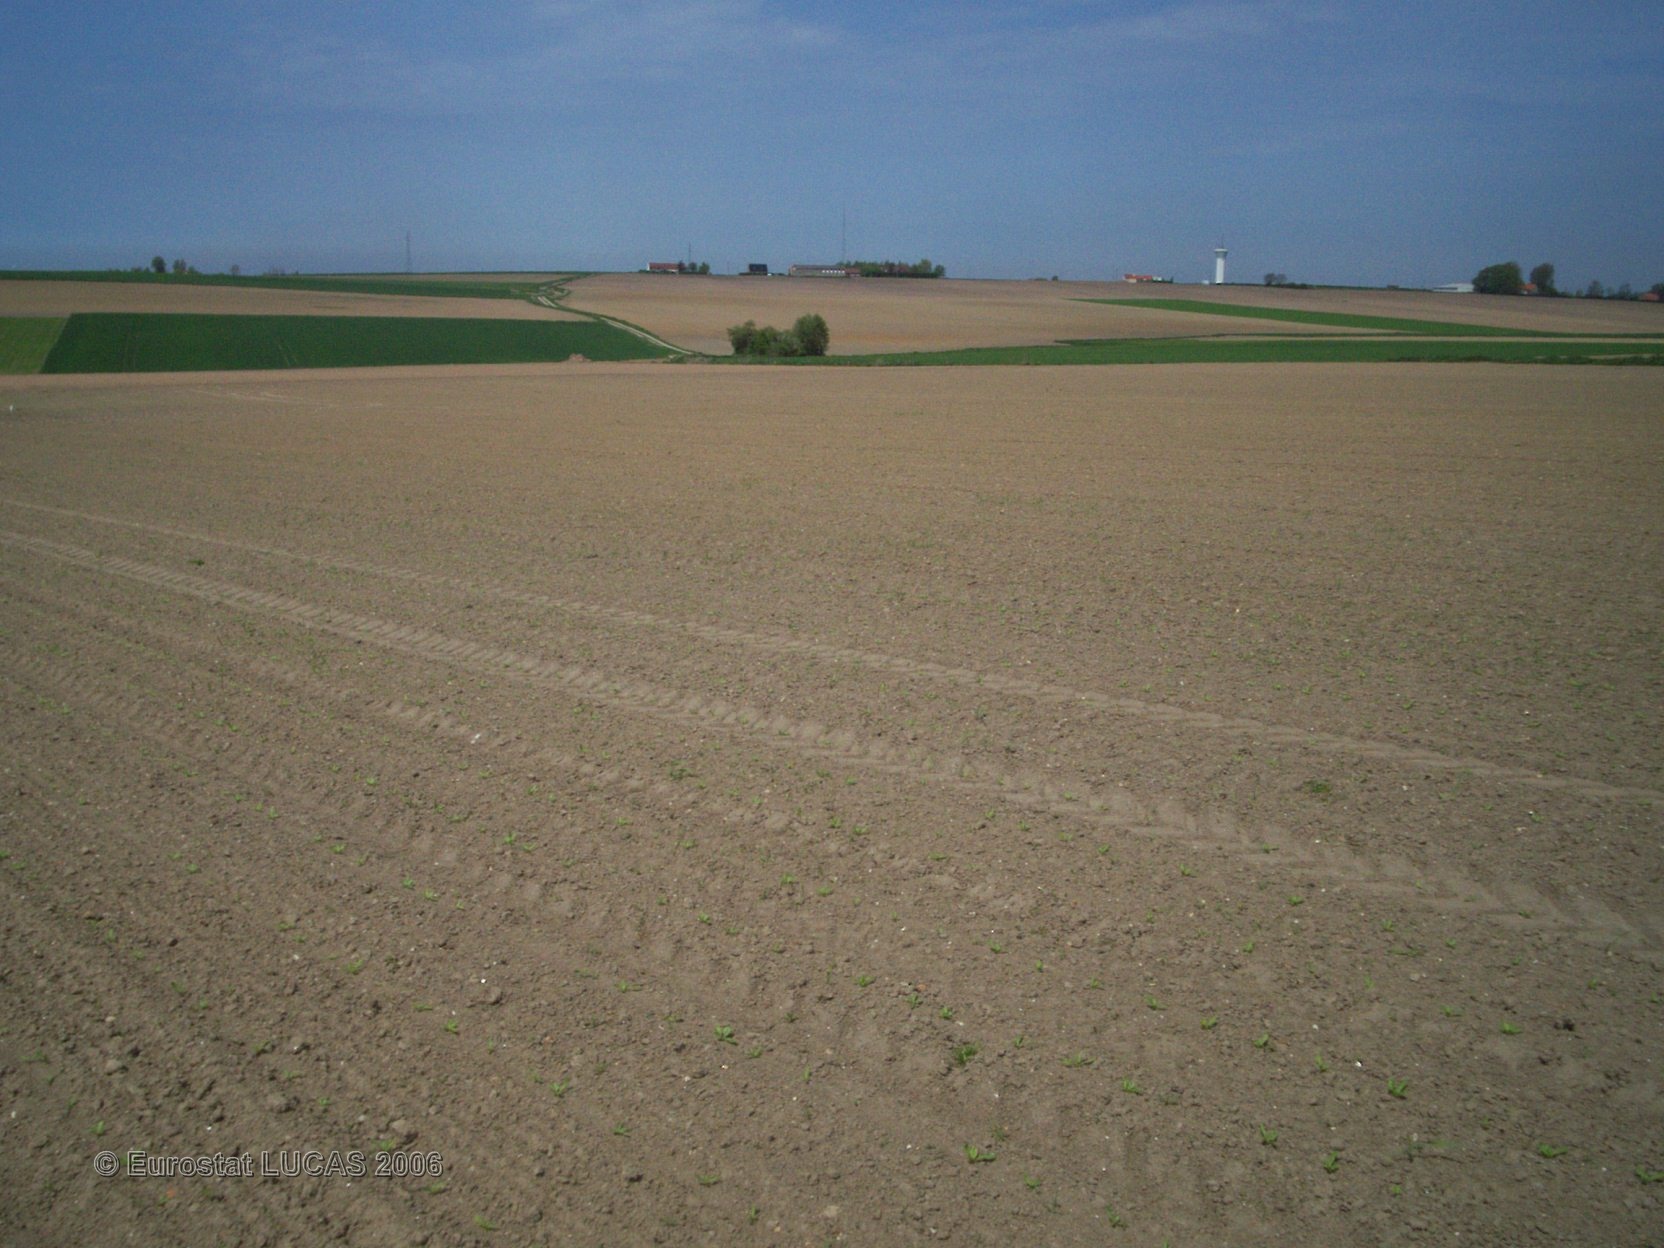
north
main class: Cropland
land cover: Sugar beet
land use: Agriculture (excluding fallow land and kitchen gardens)
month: May
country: FR
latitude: 50.9203
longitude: 2.3473
